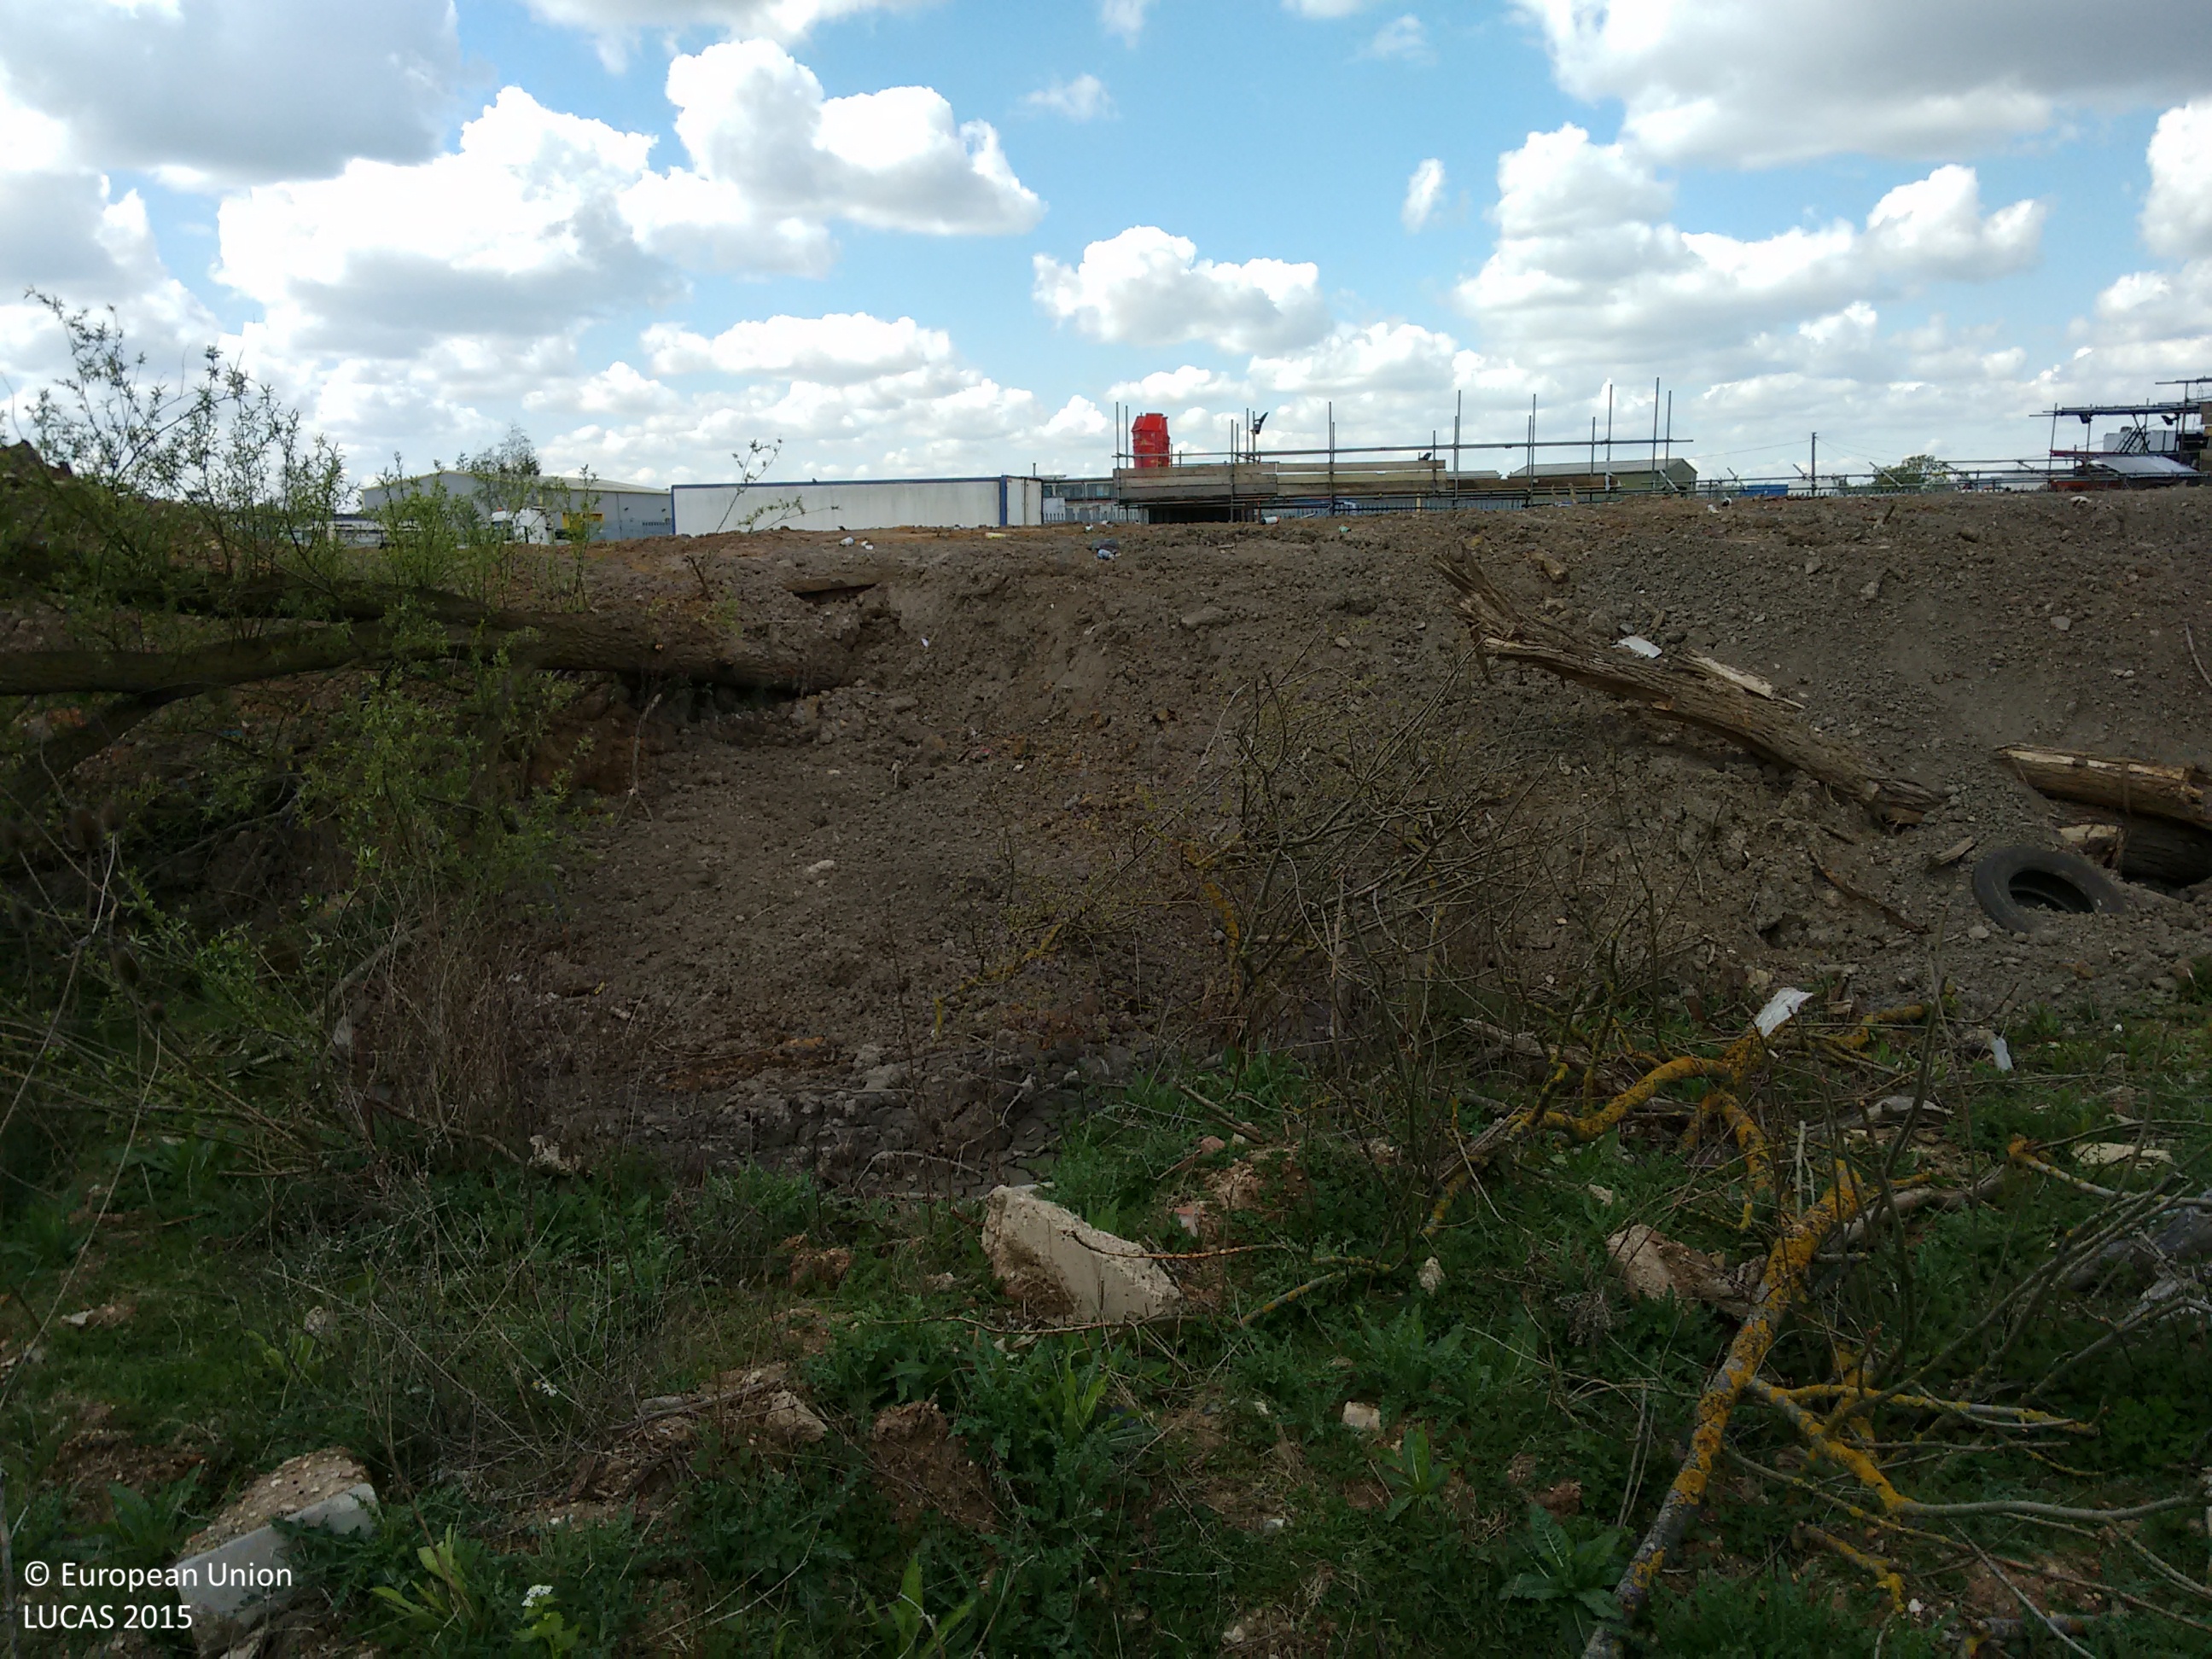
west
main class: Grassland
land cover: Spontaneously vegetated surfaces
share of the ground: > 75 %
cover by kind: herbaceous plants 90 %, unconsolidated bare surface 10 %
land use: Semi-natural and natural areas not in use
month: April
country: GB
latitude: 51.5103
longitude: -0.5137
